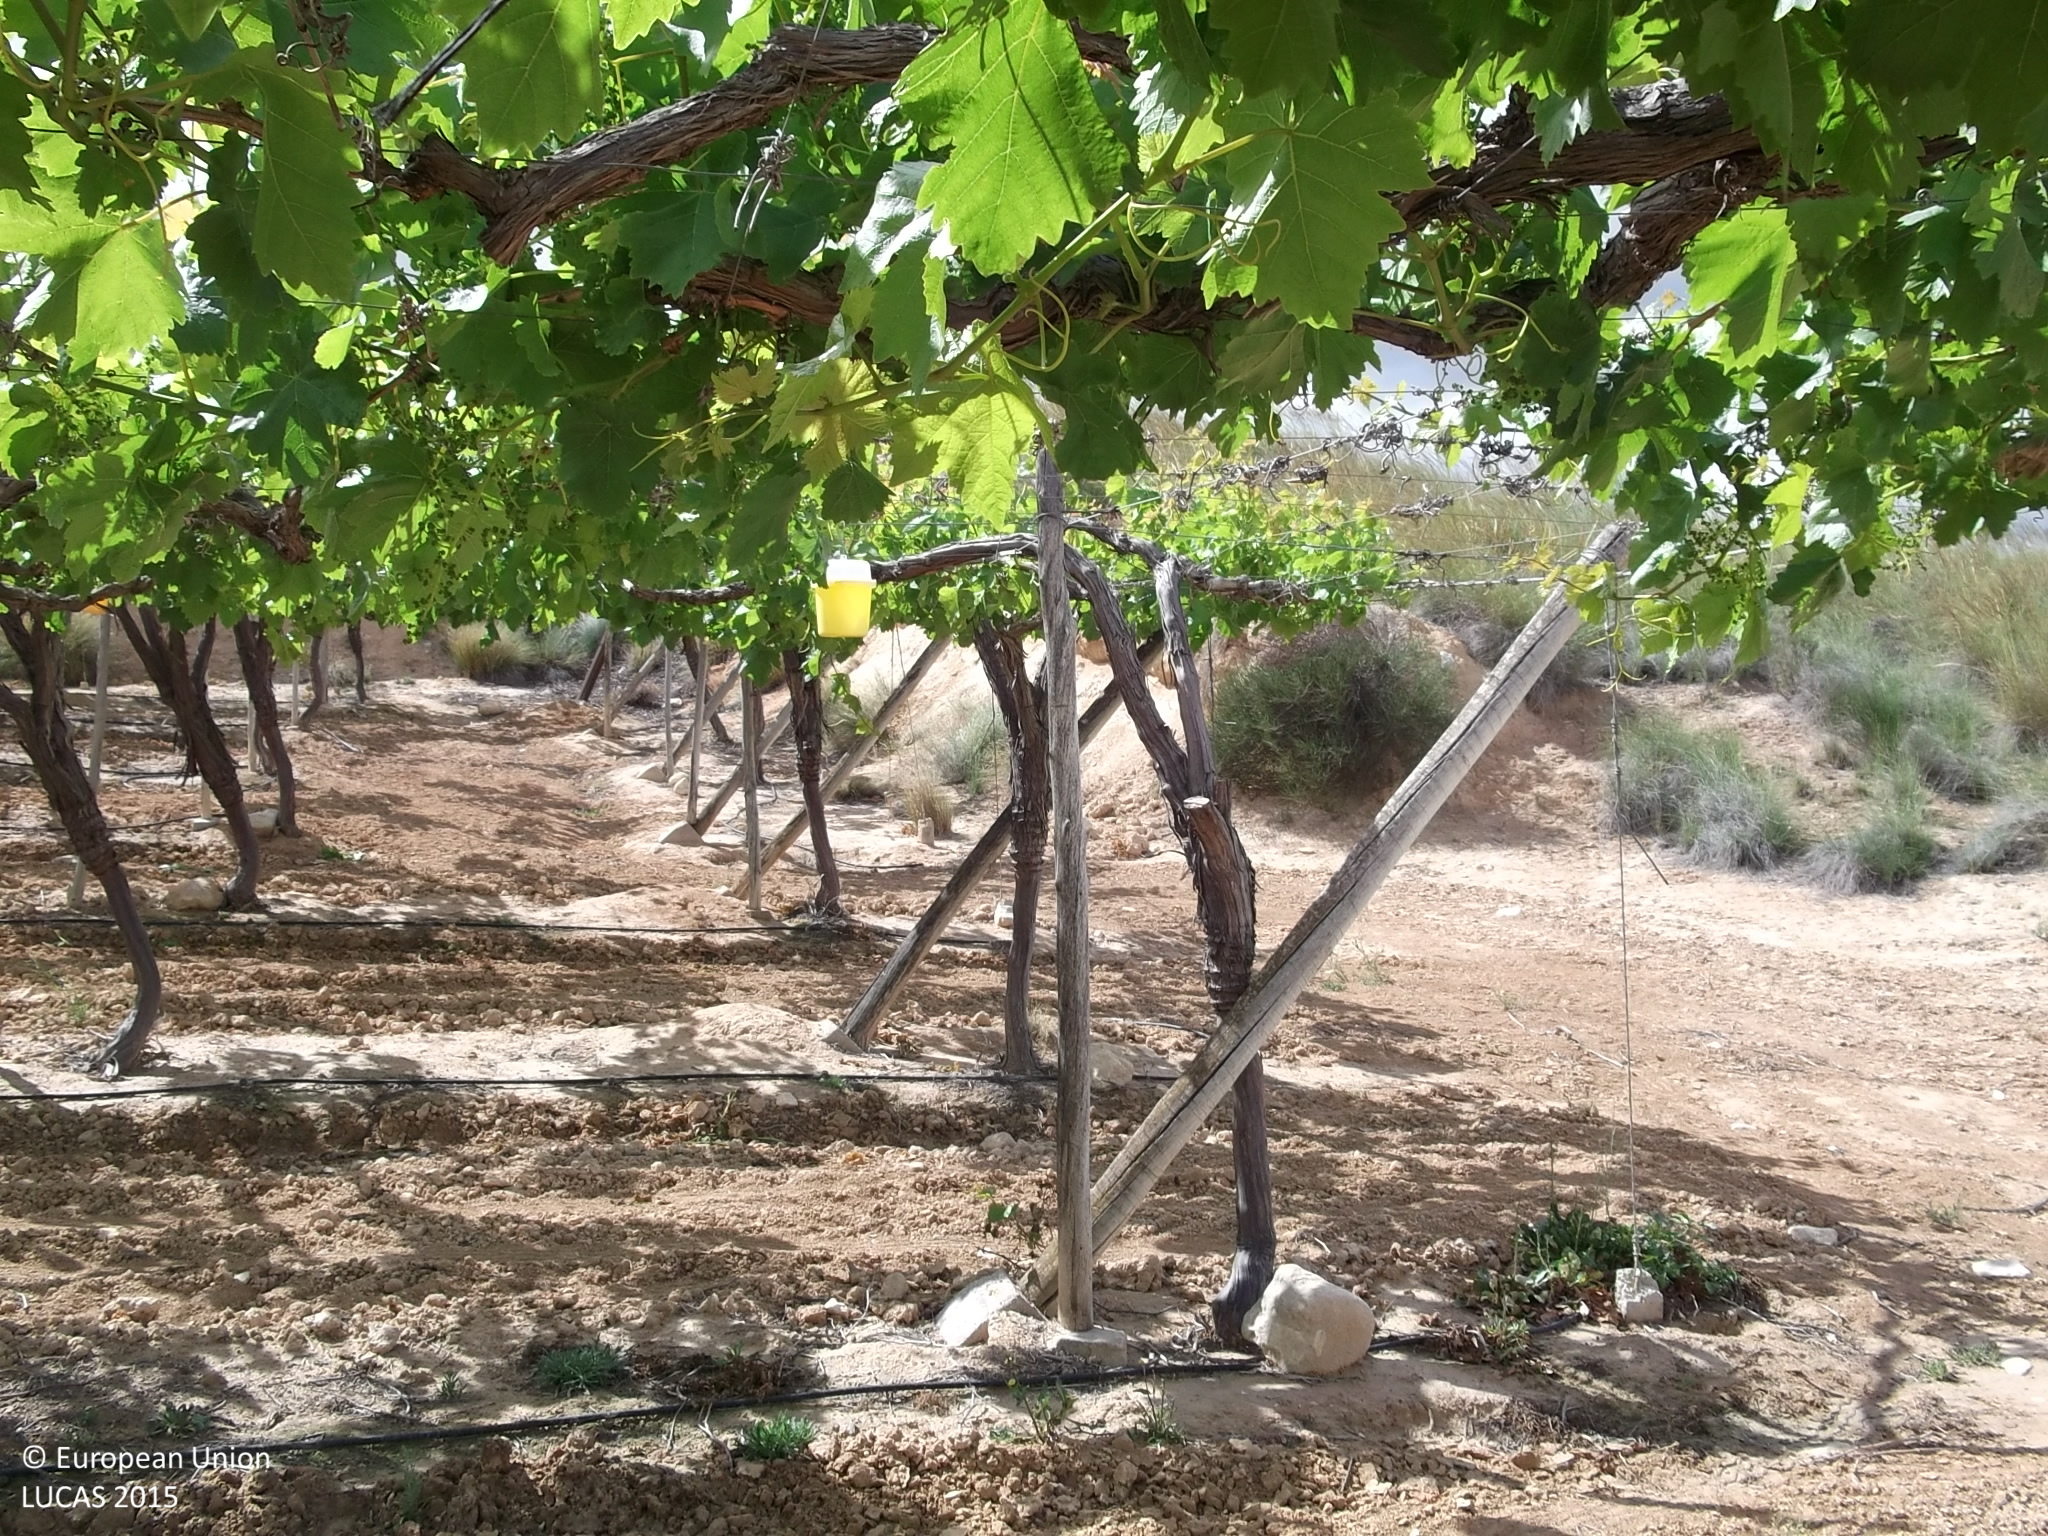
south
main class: Cropland
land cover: Vineyards
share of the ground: > 75 %
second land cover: Other bare soil
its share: > 75 %
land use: Agriculture (excluding fallow land and kitchen gardens)
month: April
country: ES
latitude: 38.2742
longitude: -1.3391
